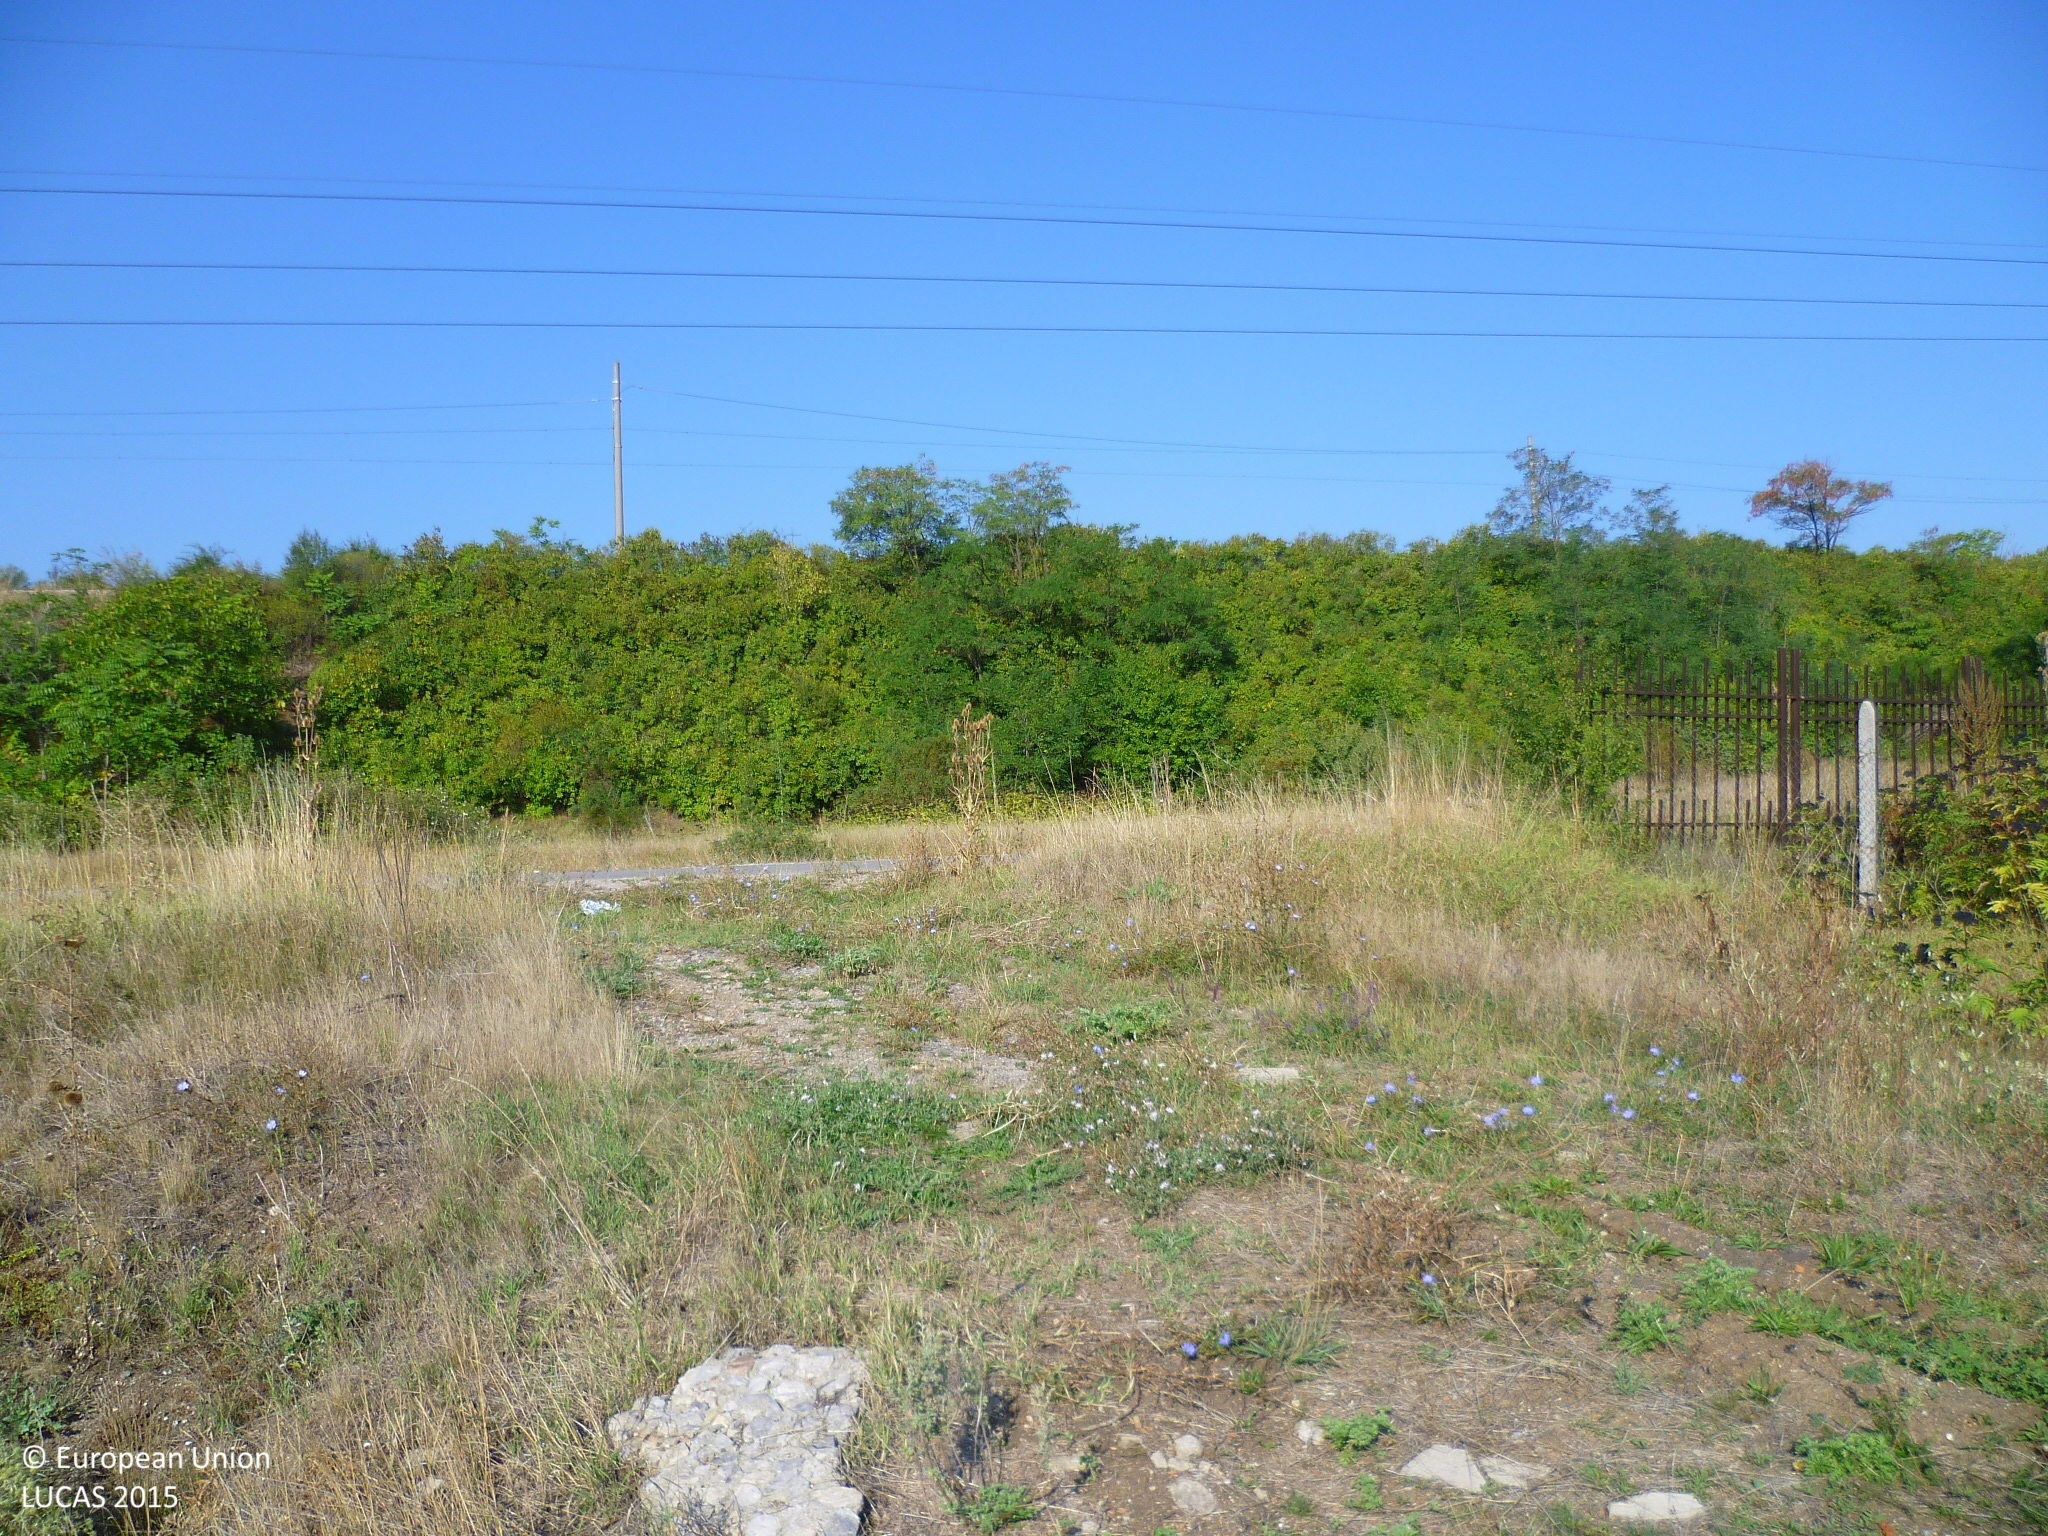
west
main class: Grassland
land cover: Grassland without tree/shrub cover
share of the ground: > 75 %
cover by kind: herbaceous plants 80 %, unconsolidated bare surface 20 %
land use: Abandoned areas
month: September
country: BG
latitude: 42.6291
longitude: 23.0403
